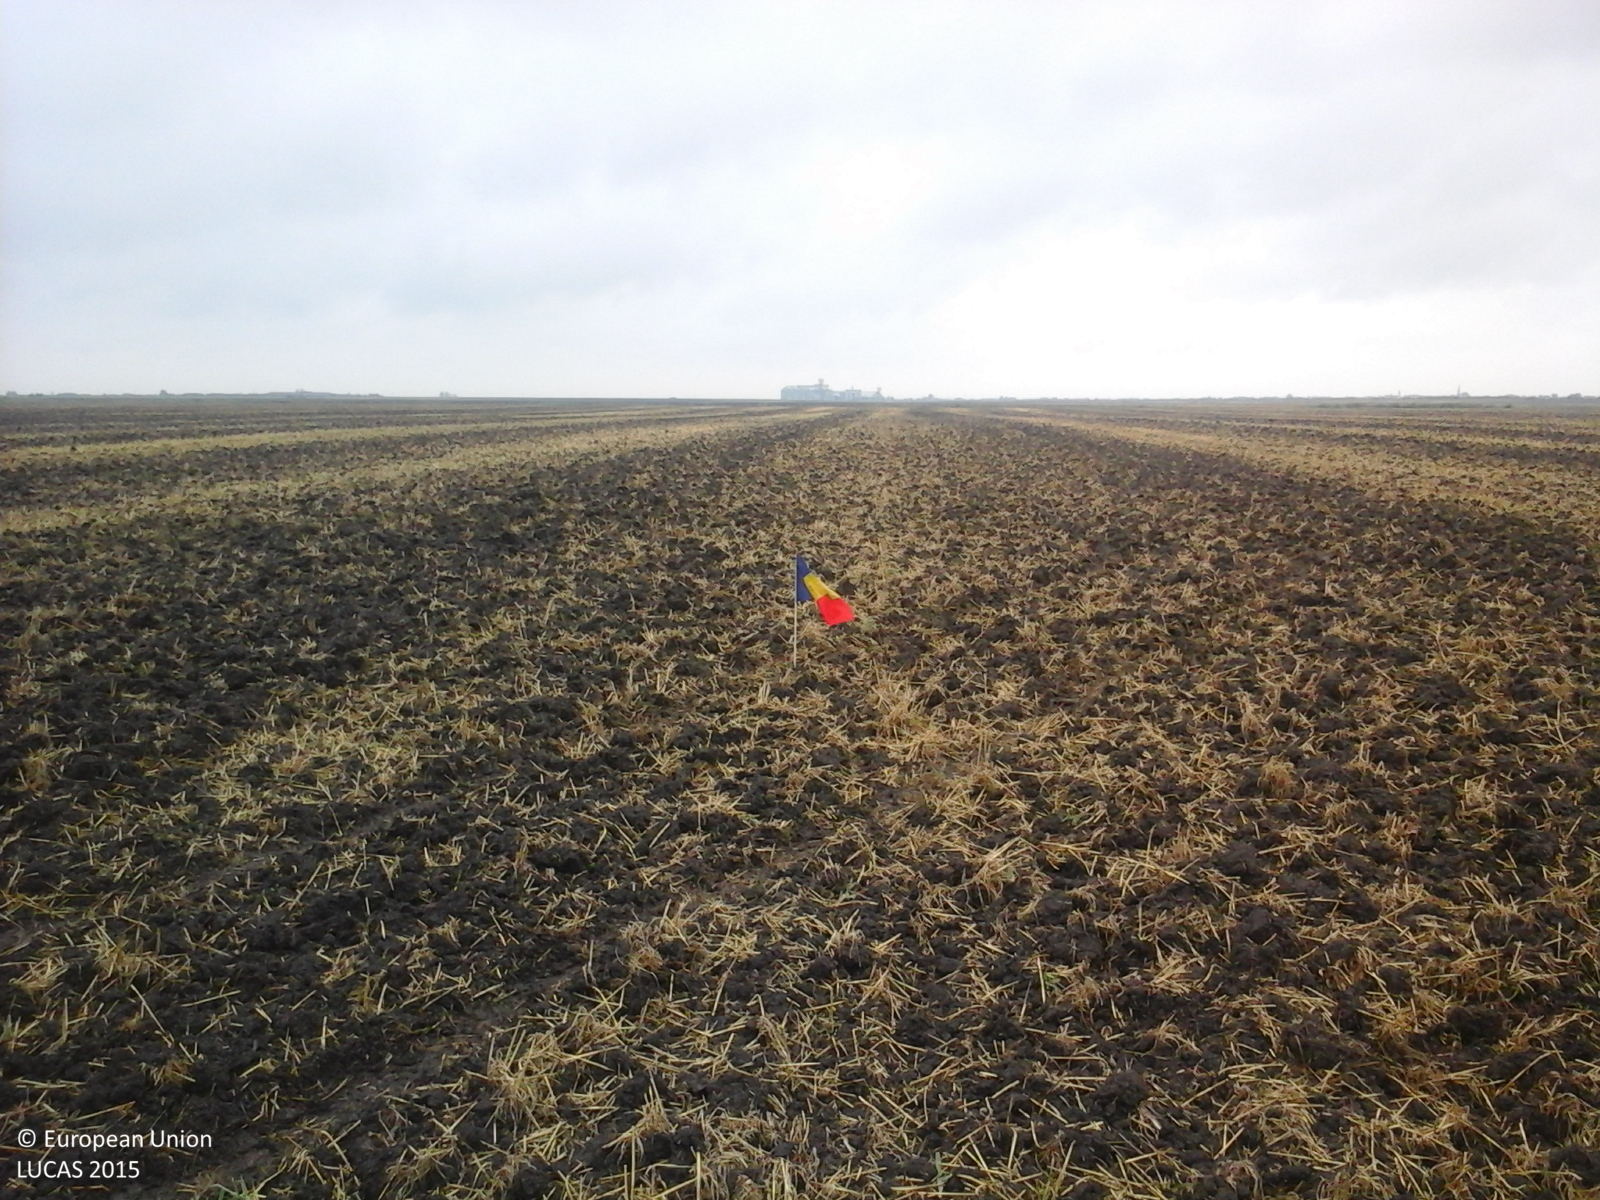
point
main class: Cropland
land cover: Common wheat
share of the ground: < 10 %
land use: Agriculture (excluding fallow land and kitchen gardens)
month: August
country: RO
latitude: 46.0019
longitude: 20.4443
